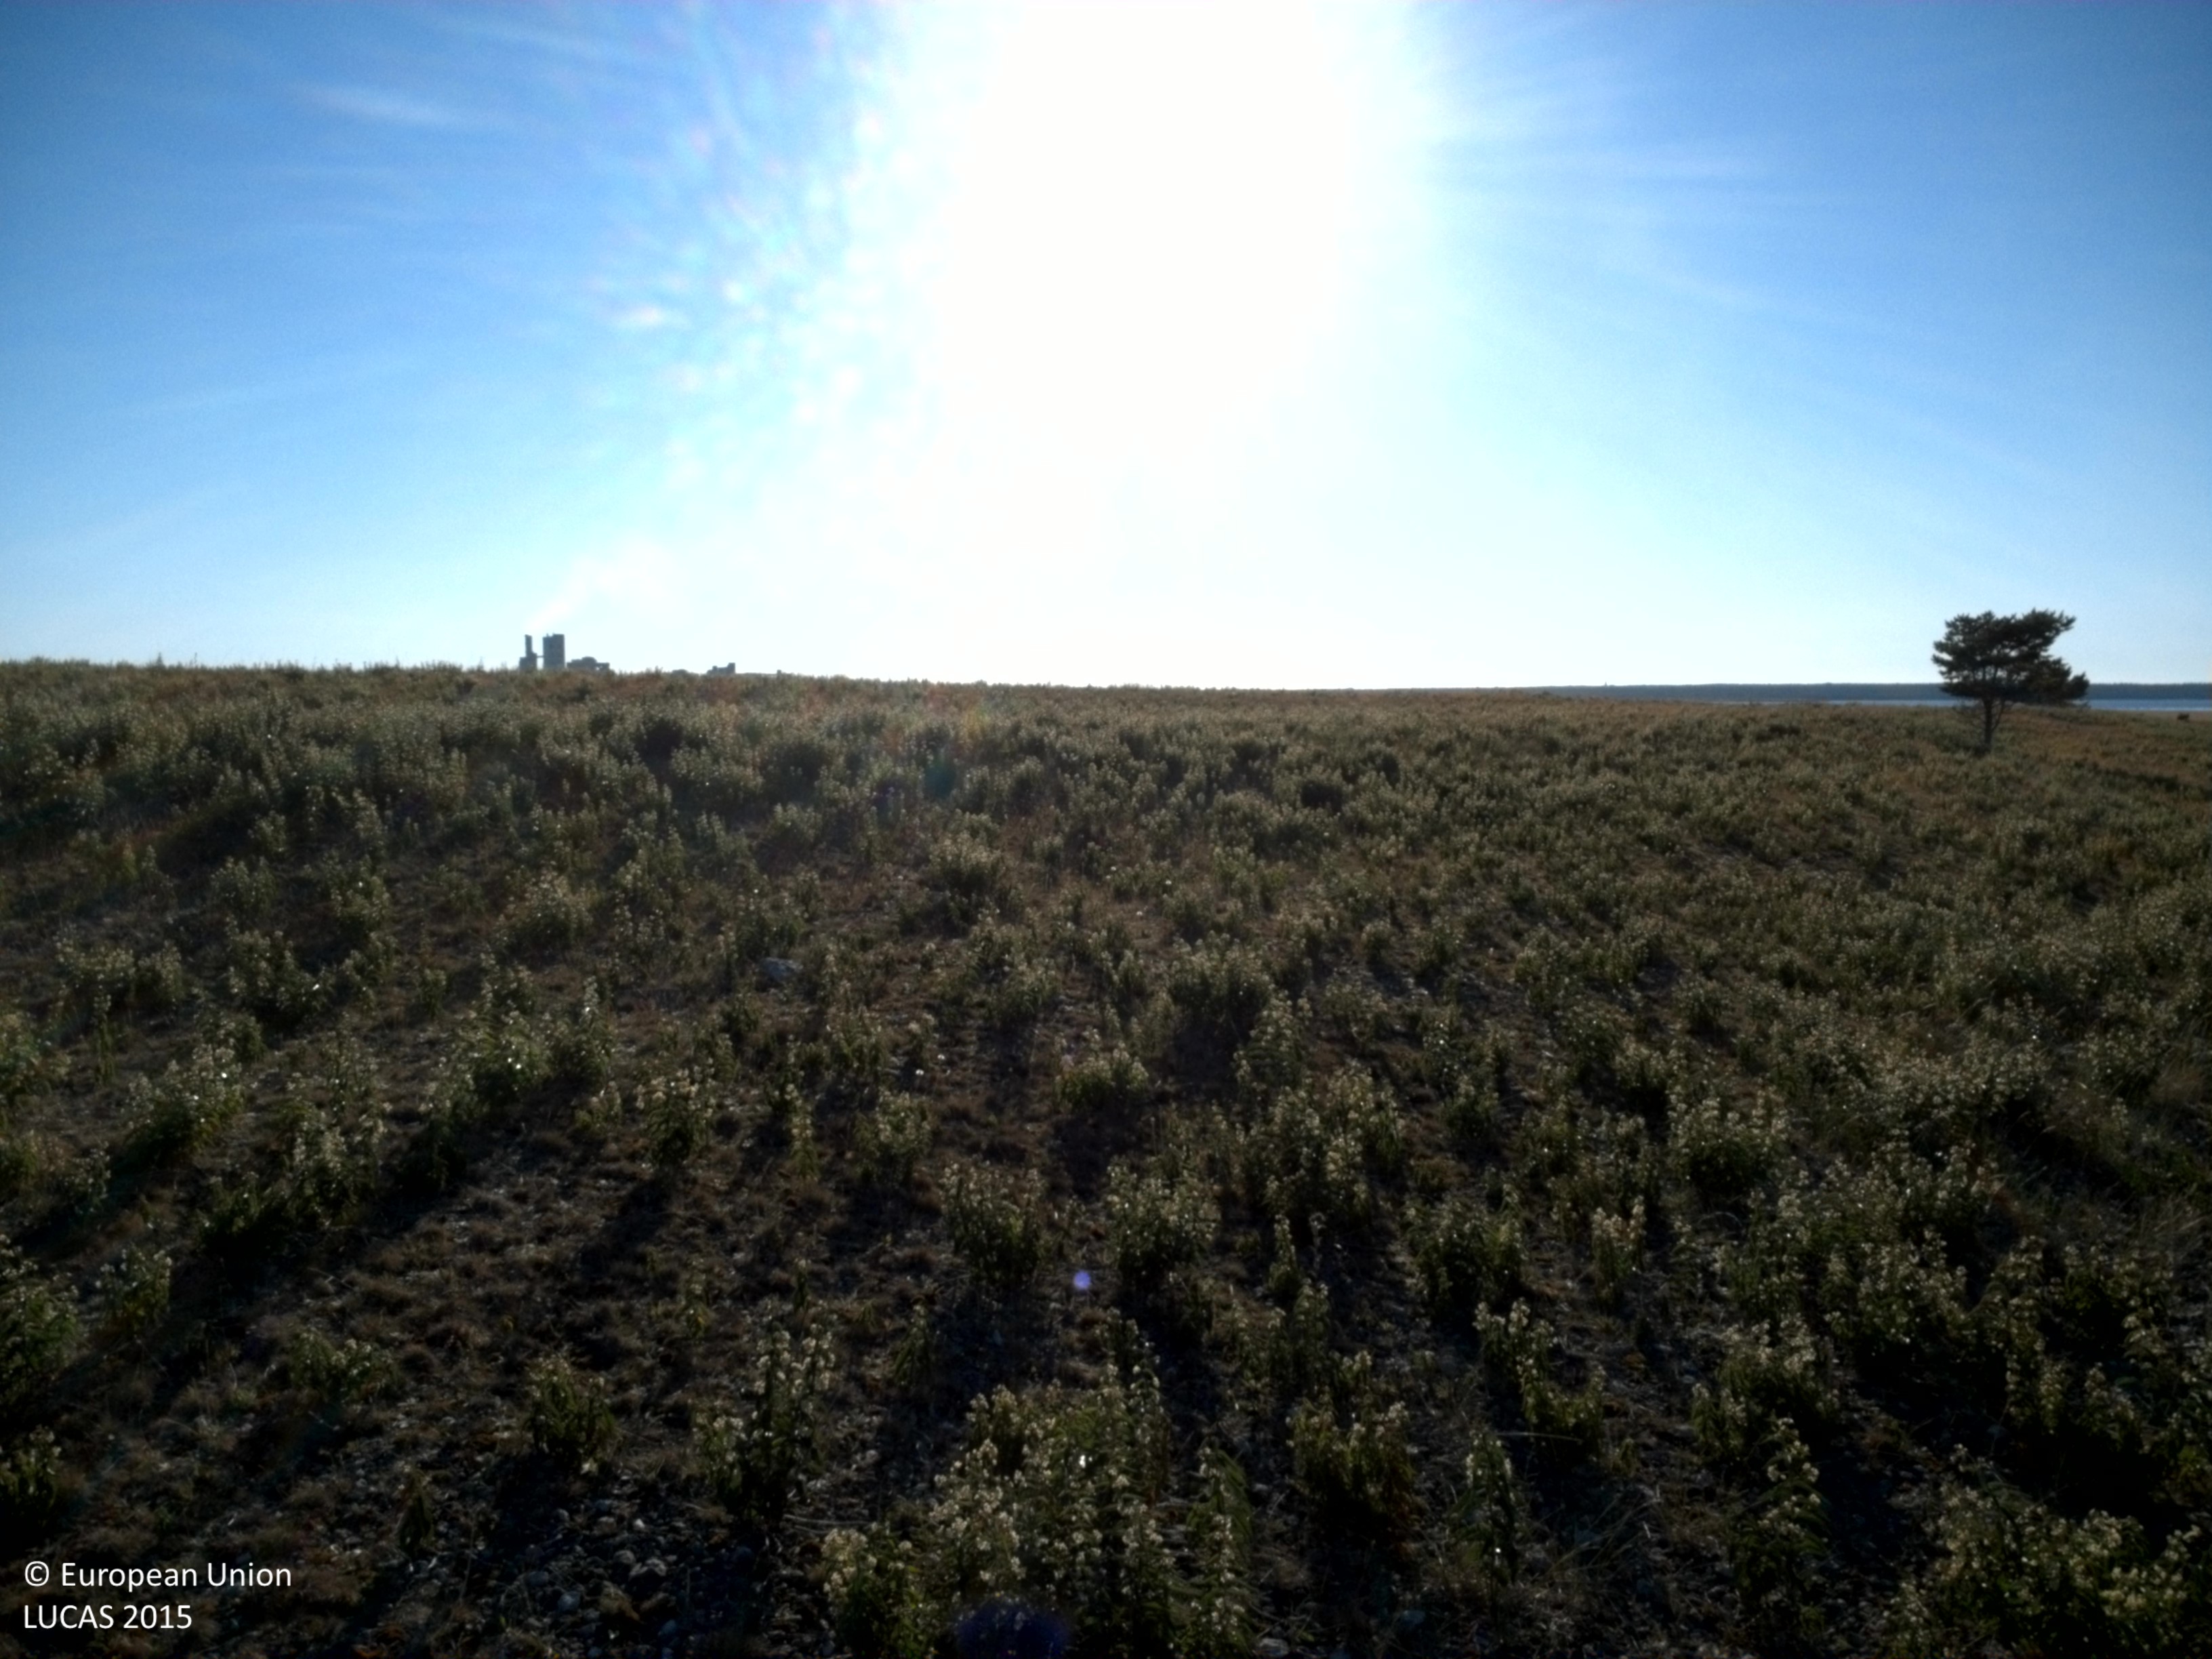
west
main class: Grassland
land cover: Grassland without tree/shrub cover
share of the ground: > 75 %
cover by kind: herbaceous plants 80 %, unconsolidated bare surface 15 %, lichens and mosses 5 %
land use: Agriculture (excluding fallow land and kitchen gardens)
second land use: Amenities, museums, leisure
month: July
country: SE
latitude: 57.7096
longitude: 18.8552
